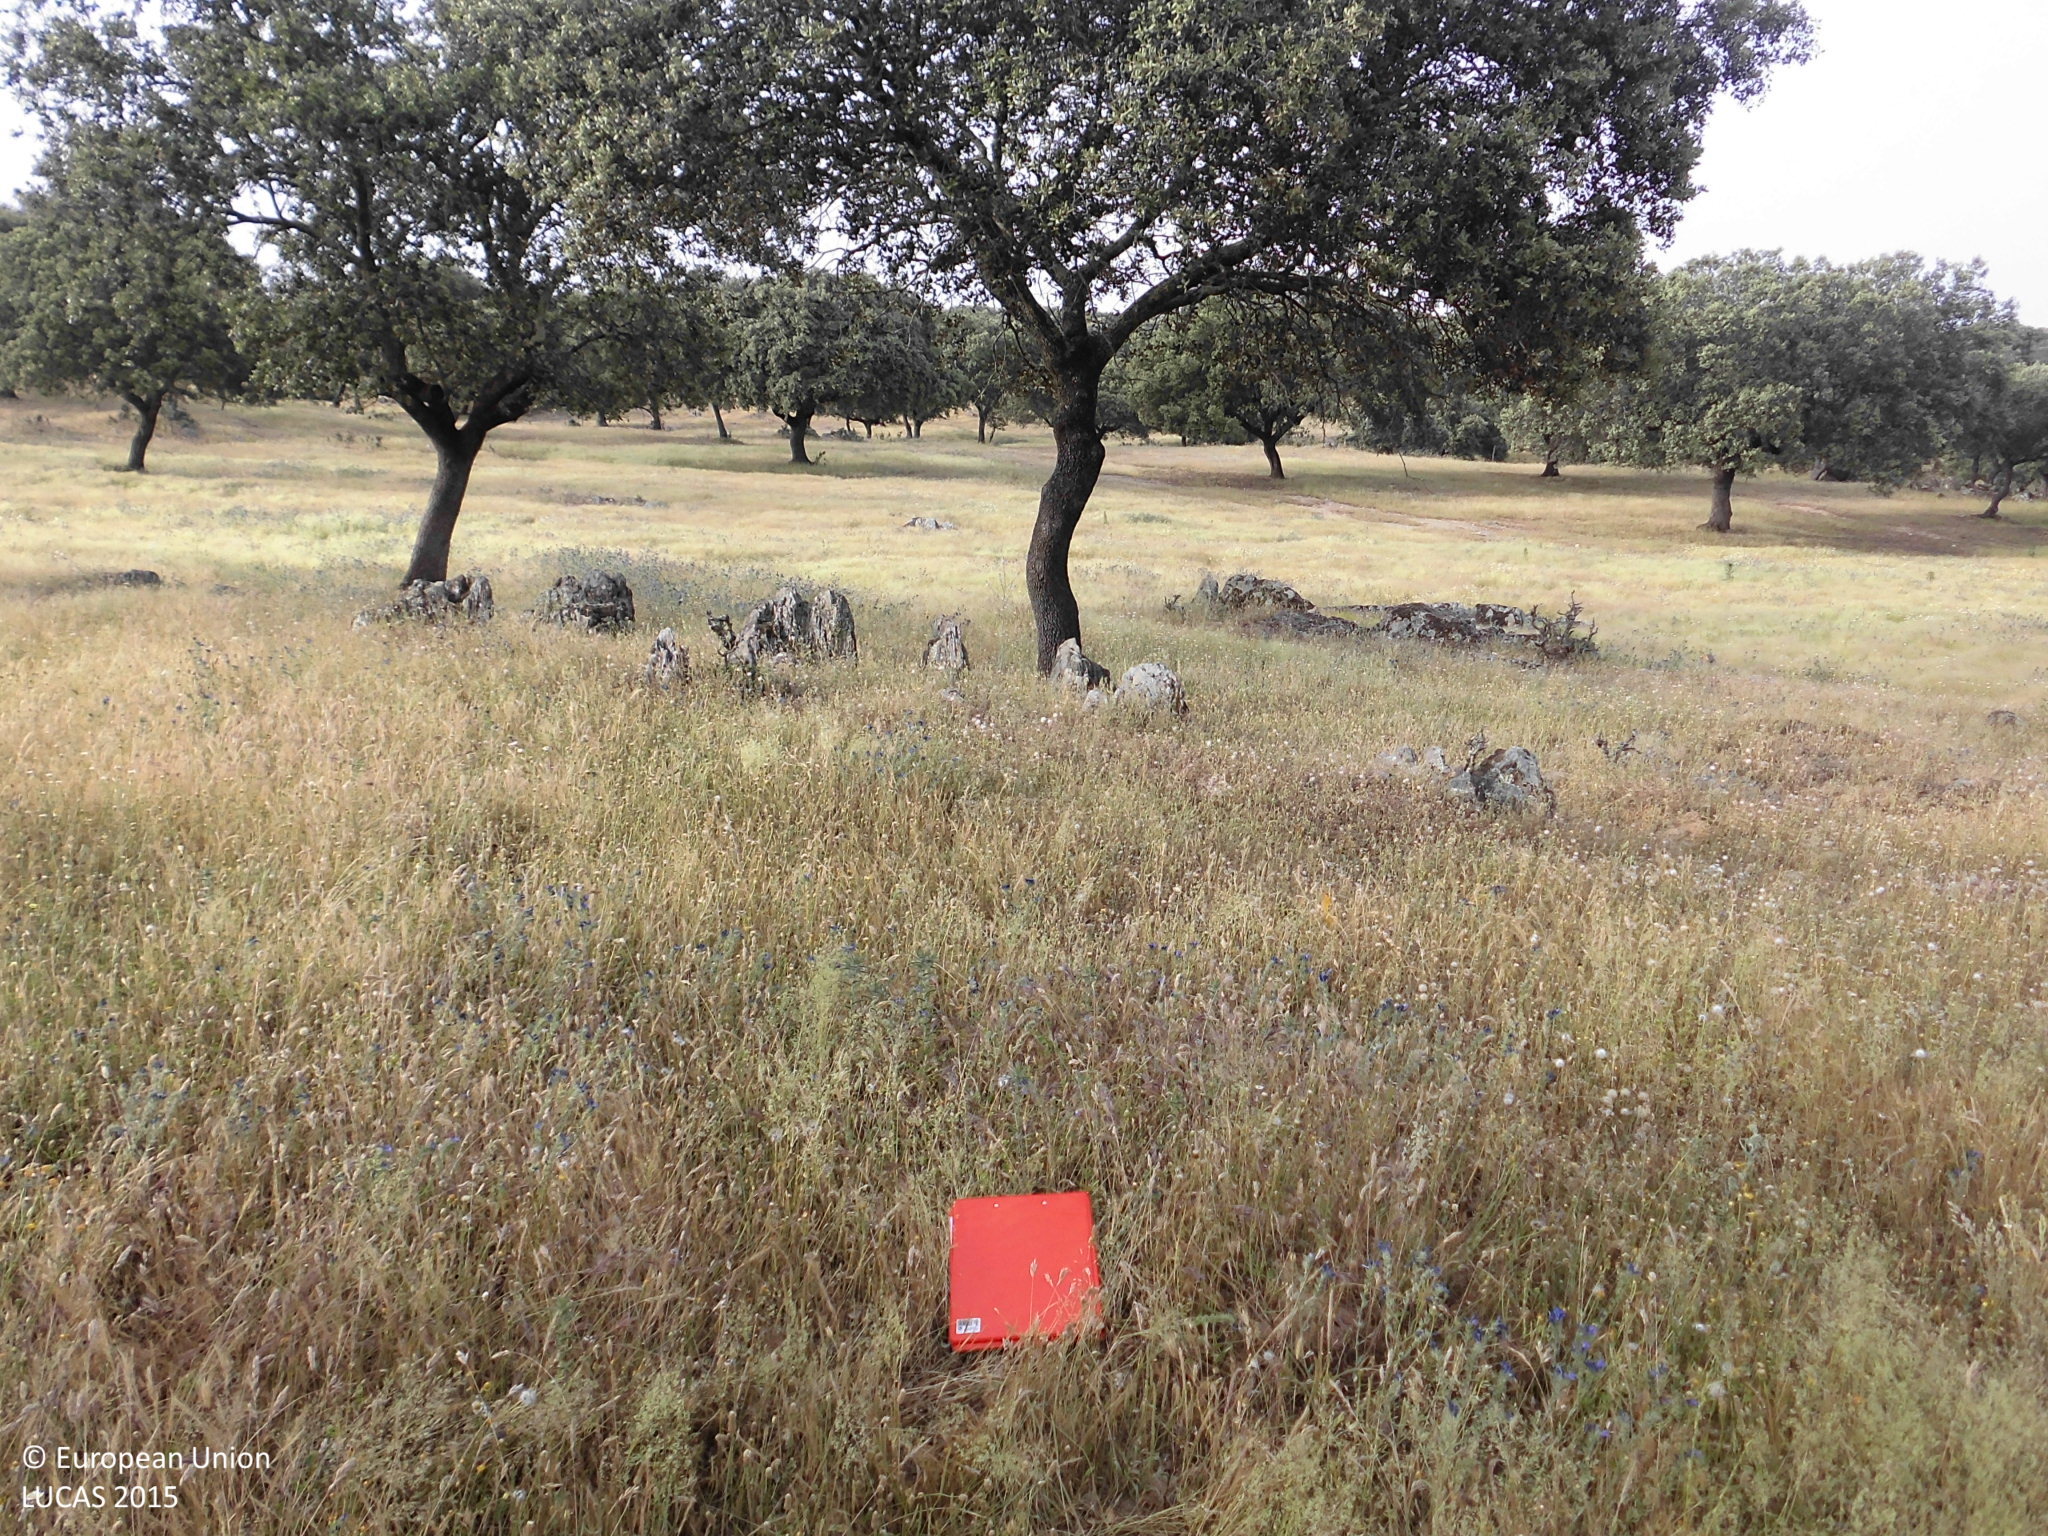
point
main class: Woodland
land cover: Broadleaved woodland
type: broadleaved evergreen forest
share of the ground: 25 - 50 %
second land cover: Grassland without tree/shrub cover
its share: > 75 %
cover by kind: shrubs 65 %, broadleaved forest trees 35 %
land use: Forestry
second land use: Agriculture (excluding fallow land and kitchen gardens)
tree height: > 5 m
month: May
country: ES
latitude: 39.6475
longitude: -6.0889
